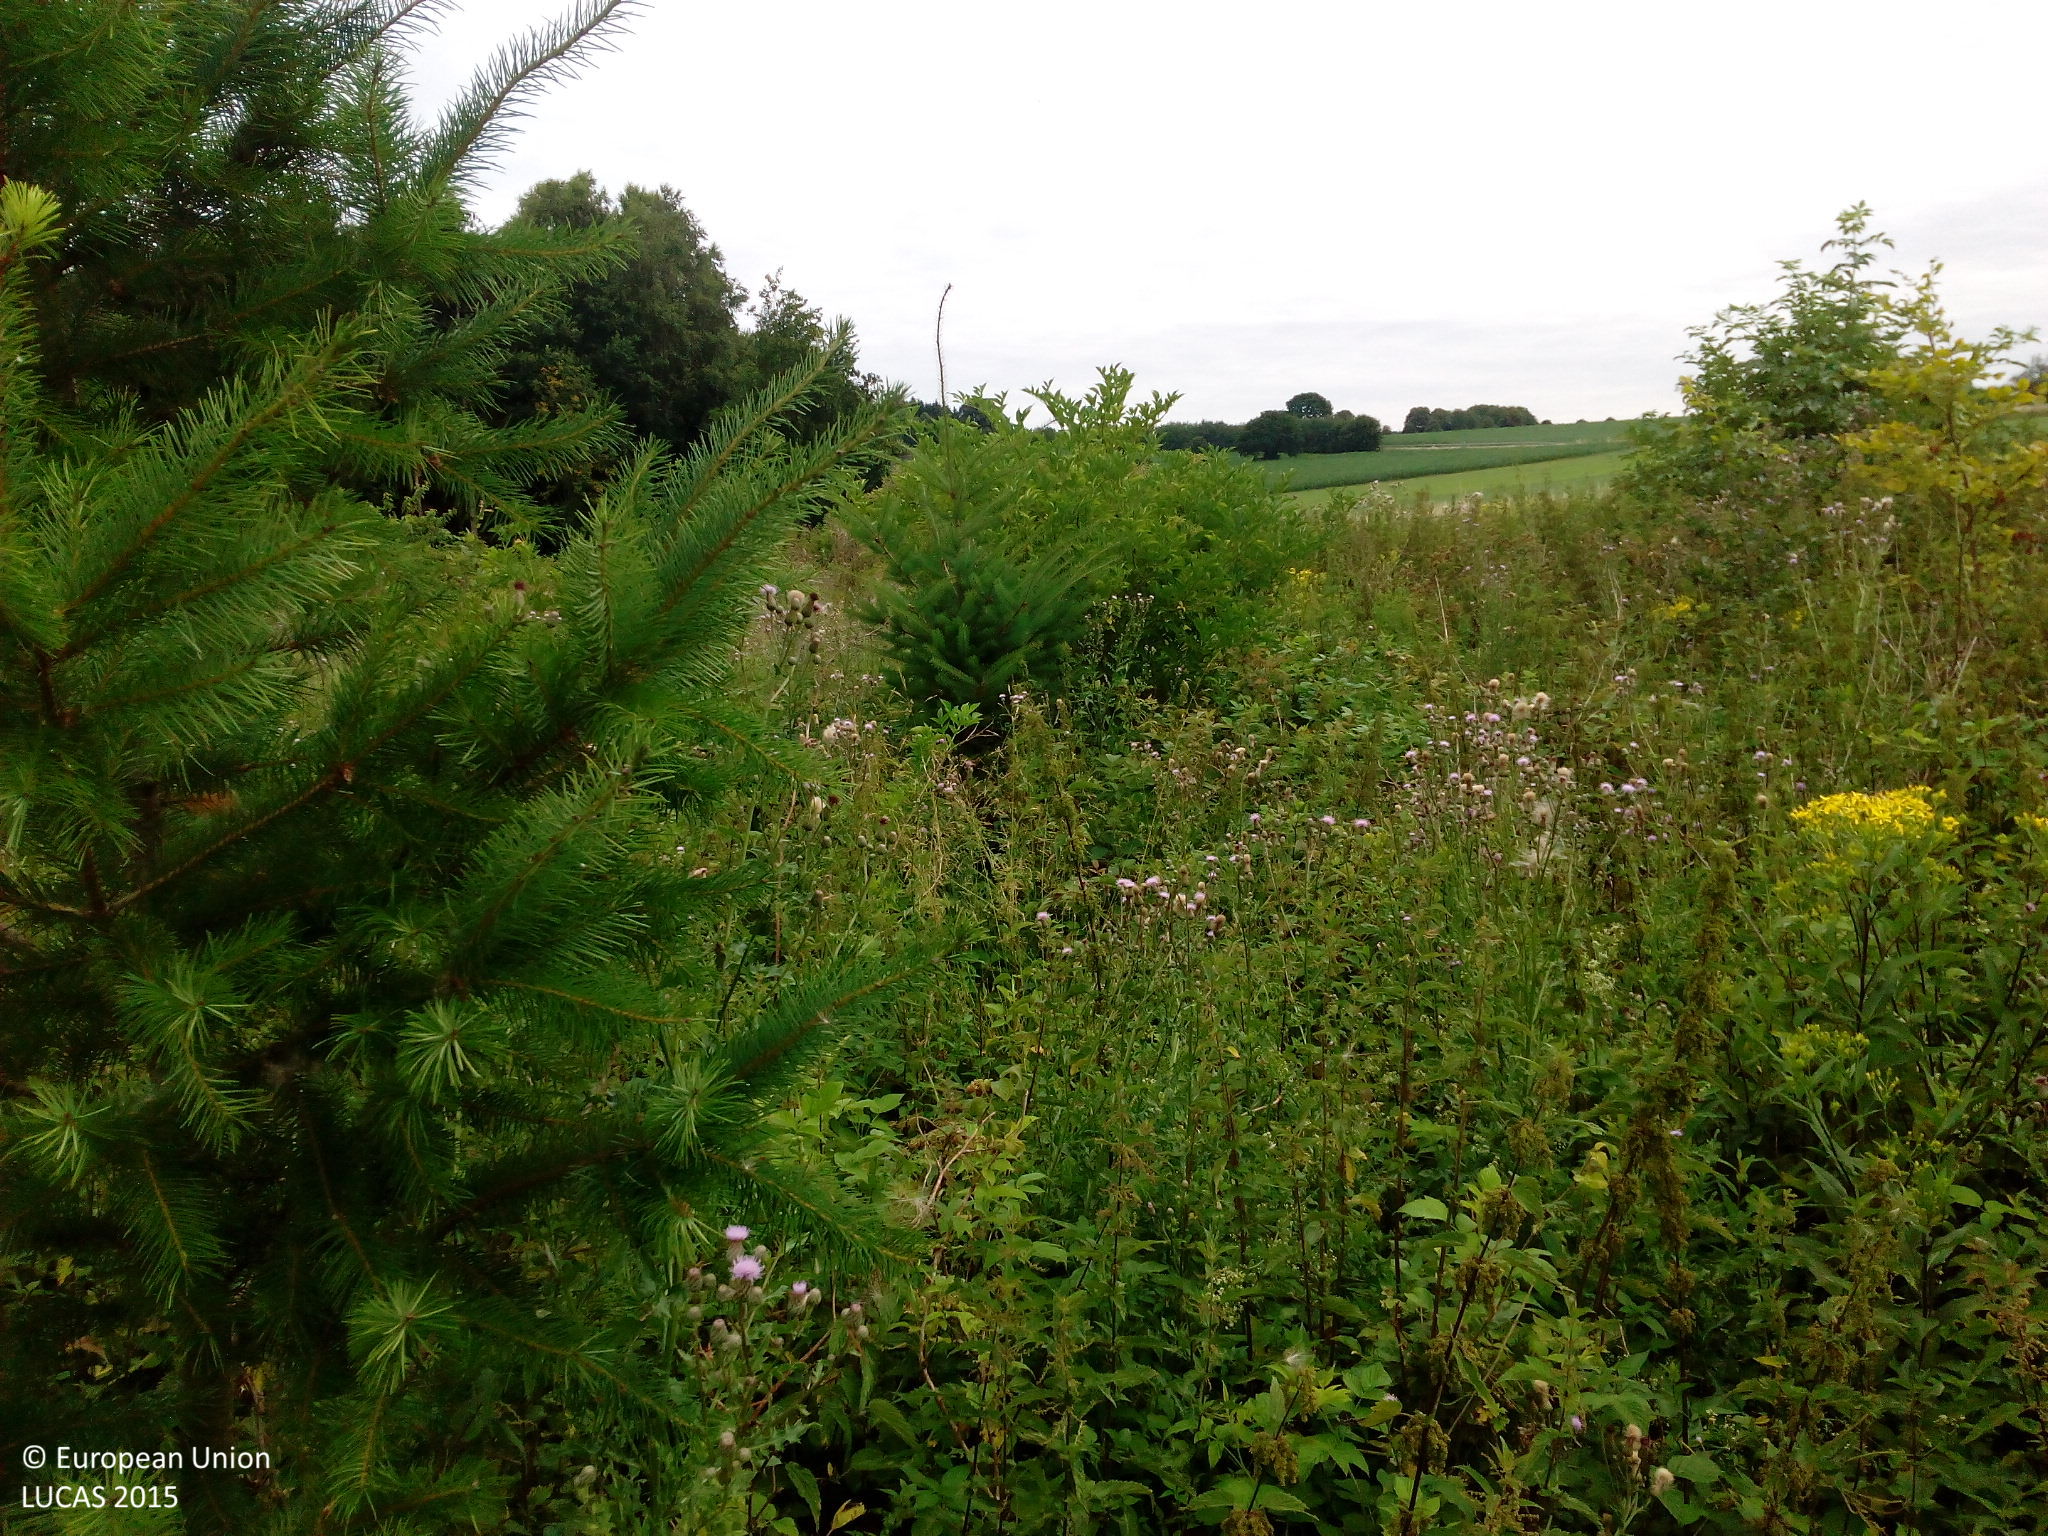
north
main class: Shrubland
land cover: Shrubland with sparse tree cover
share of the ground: 50 - 75 %
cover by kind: shrubs 65 %, herbaceous plants 30 %, coniferous forest trees 5 %
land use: Forestry
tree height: < 5 m
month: July
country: DE
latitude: 49.8241
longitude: 7.1228
